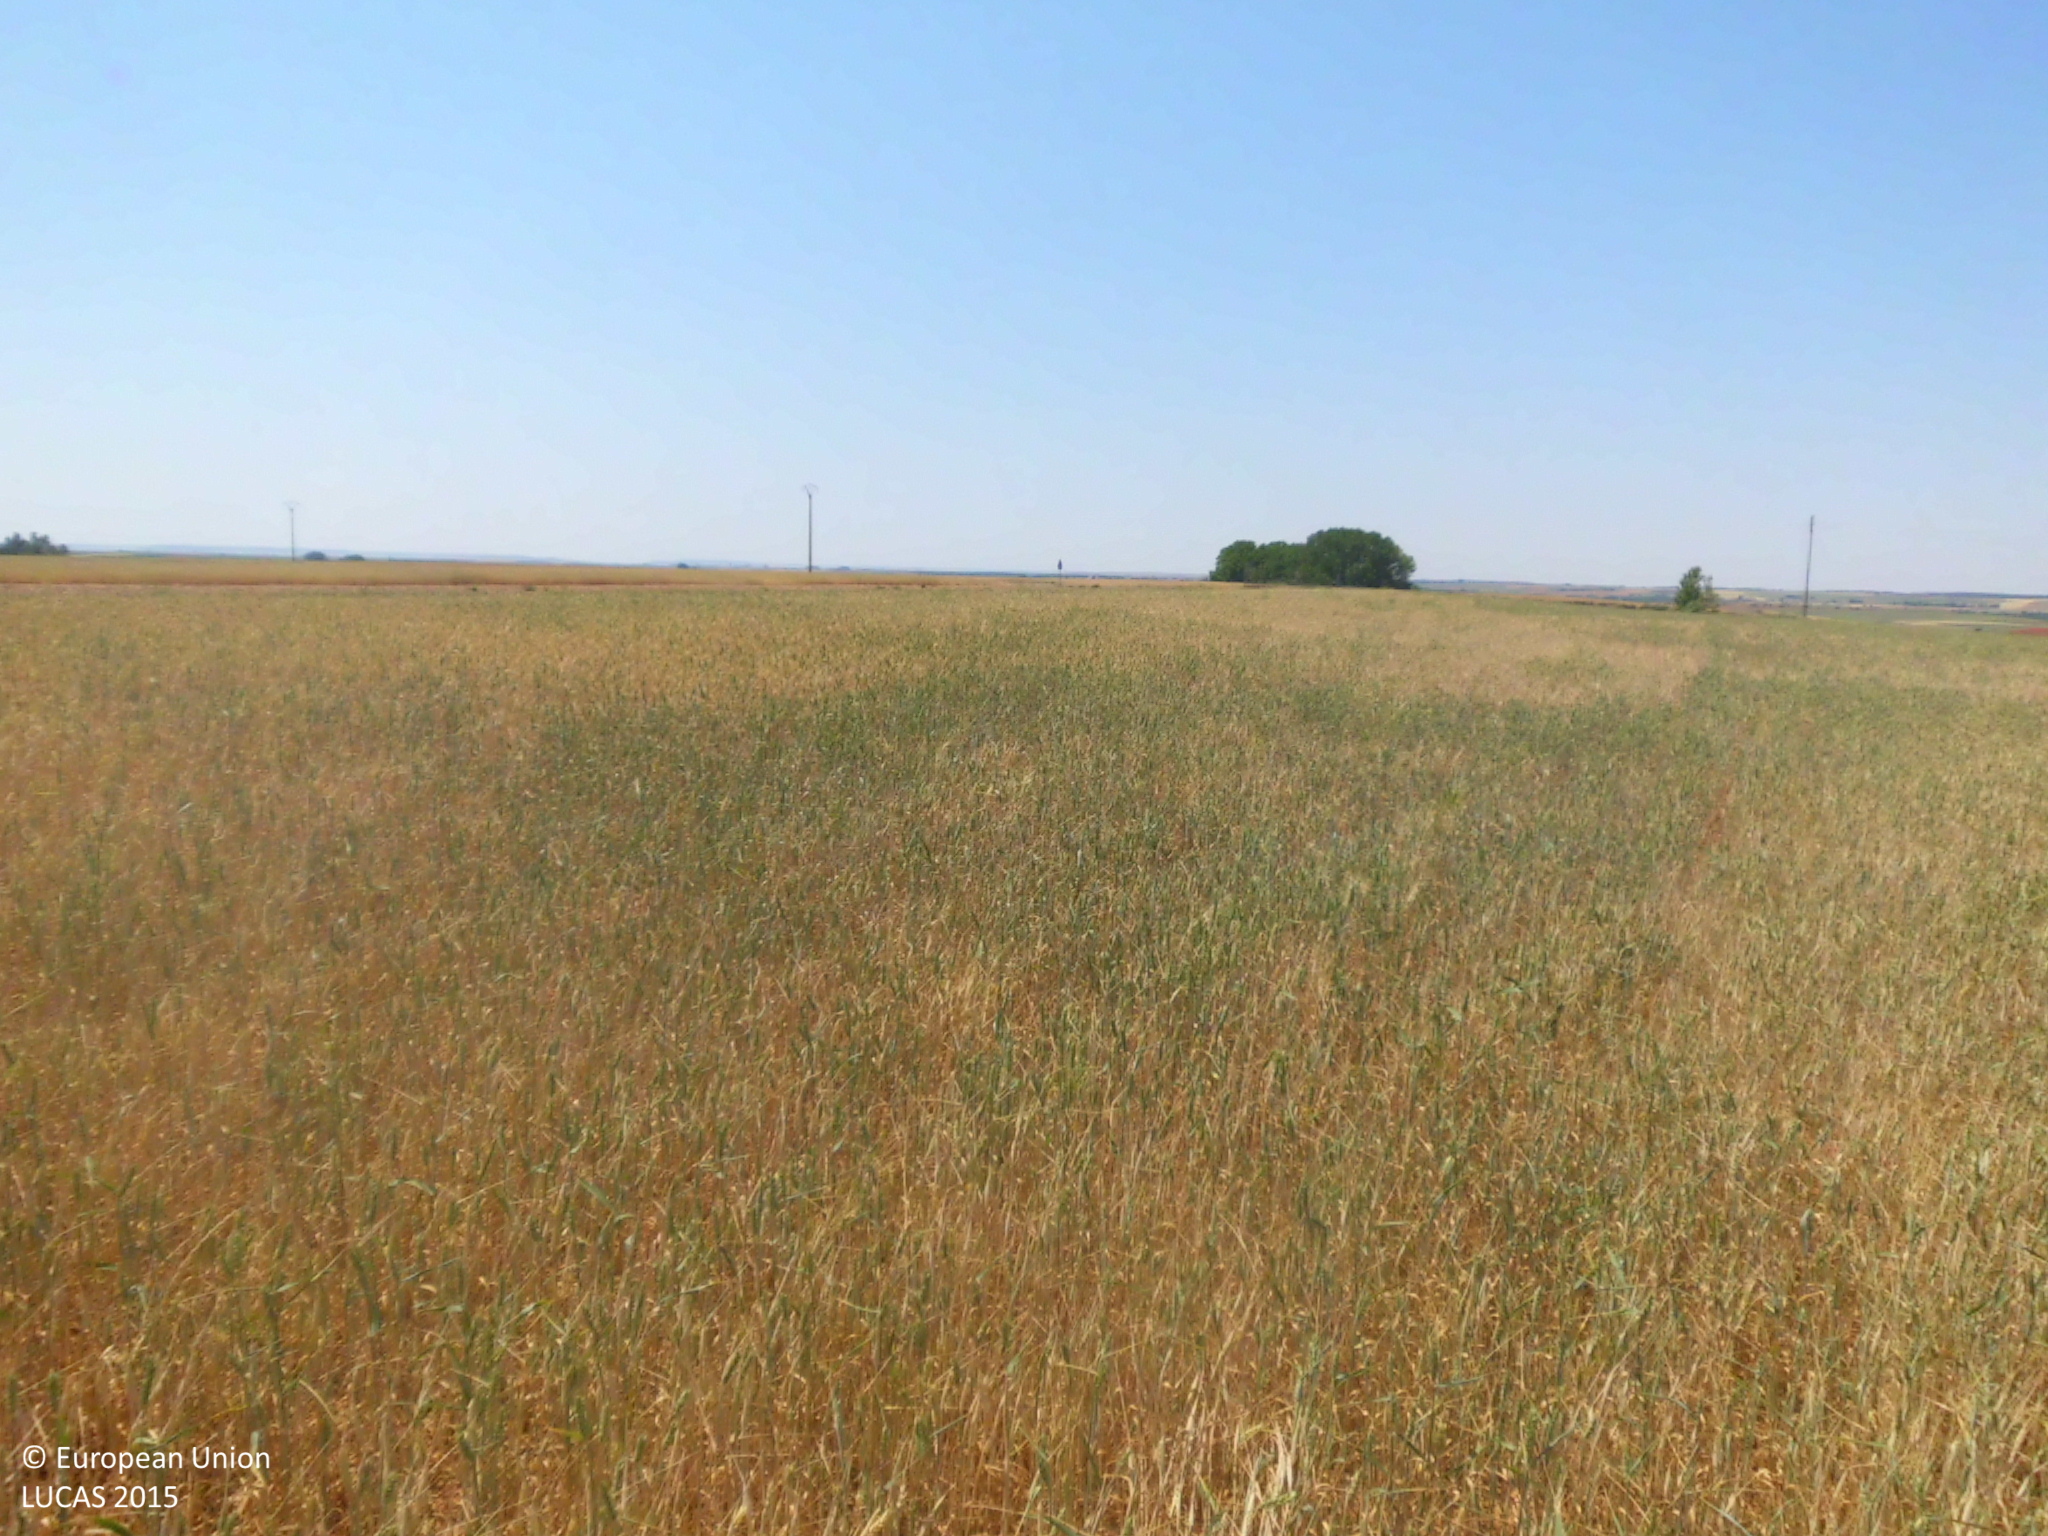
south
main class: Cropland
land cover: Common wheat
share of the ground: > 75 %
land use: Agriculture (excluding fallow land and kitchen gardens)
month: June
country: ES
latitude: 42.5048
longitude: -4.2238
